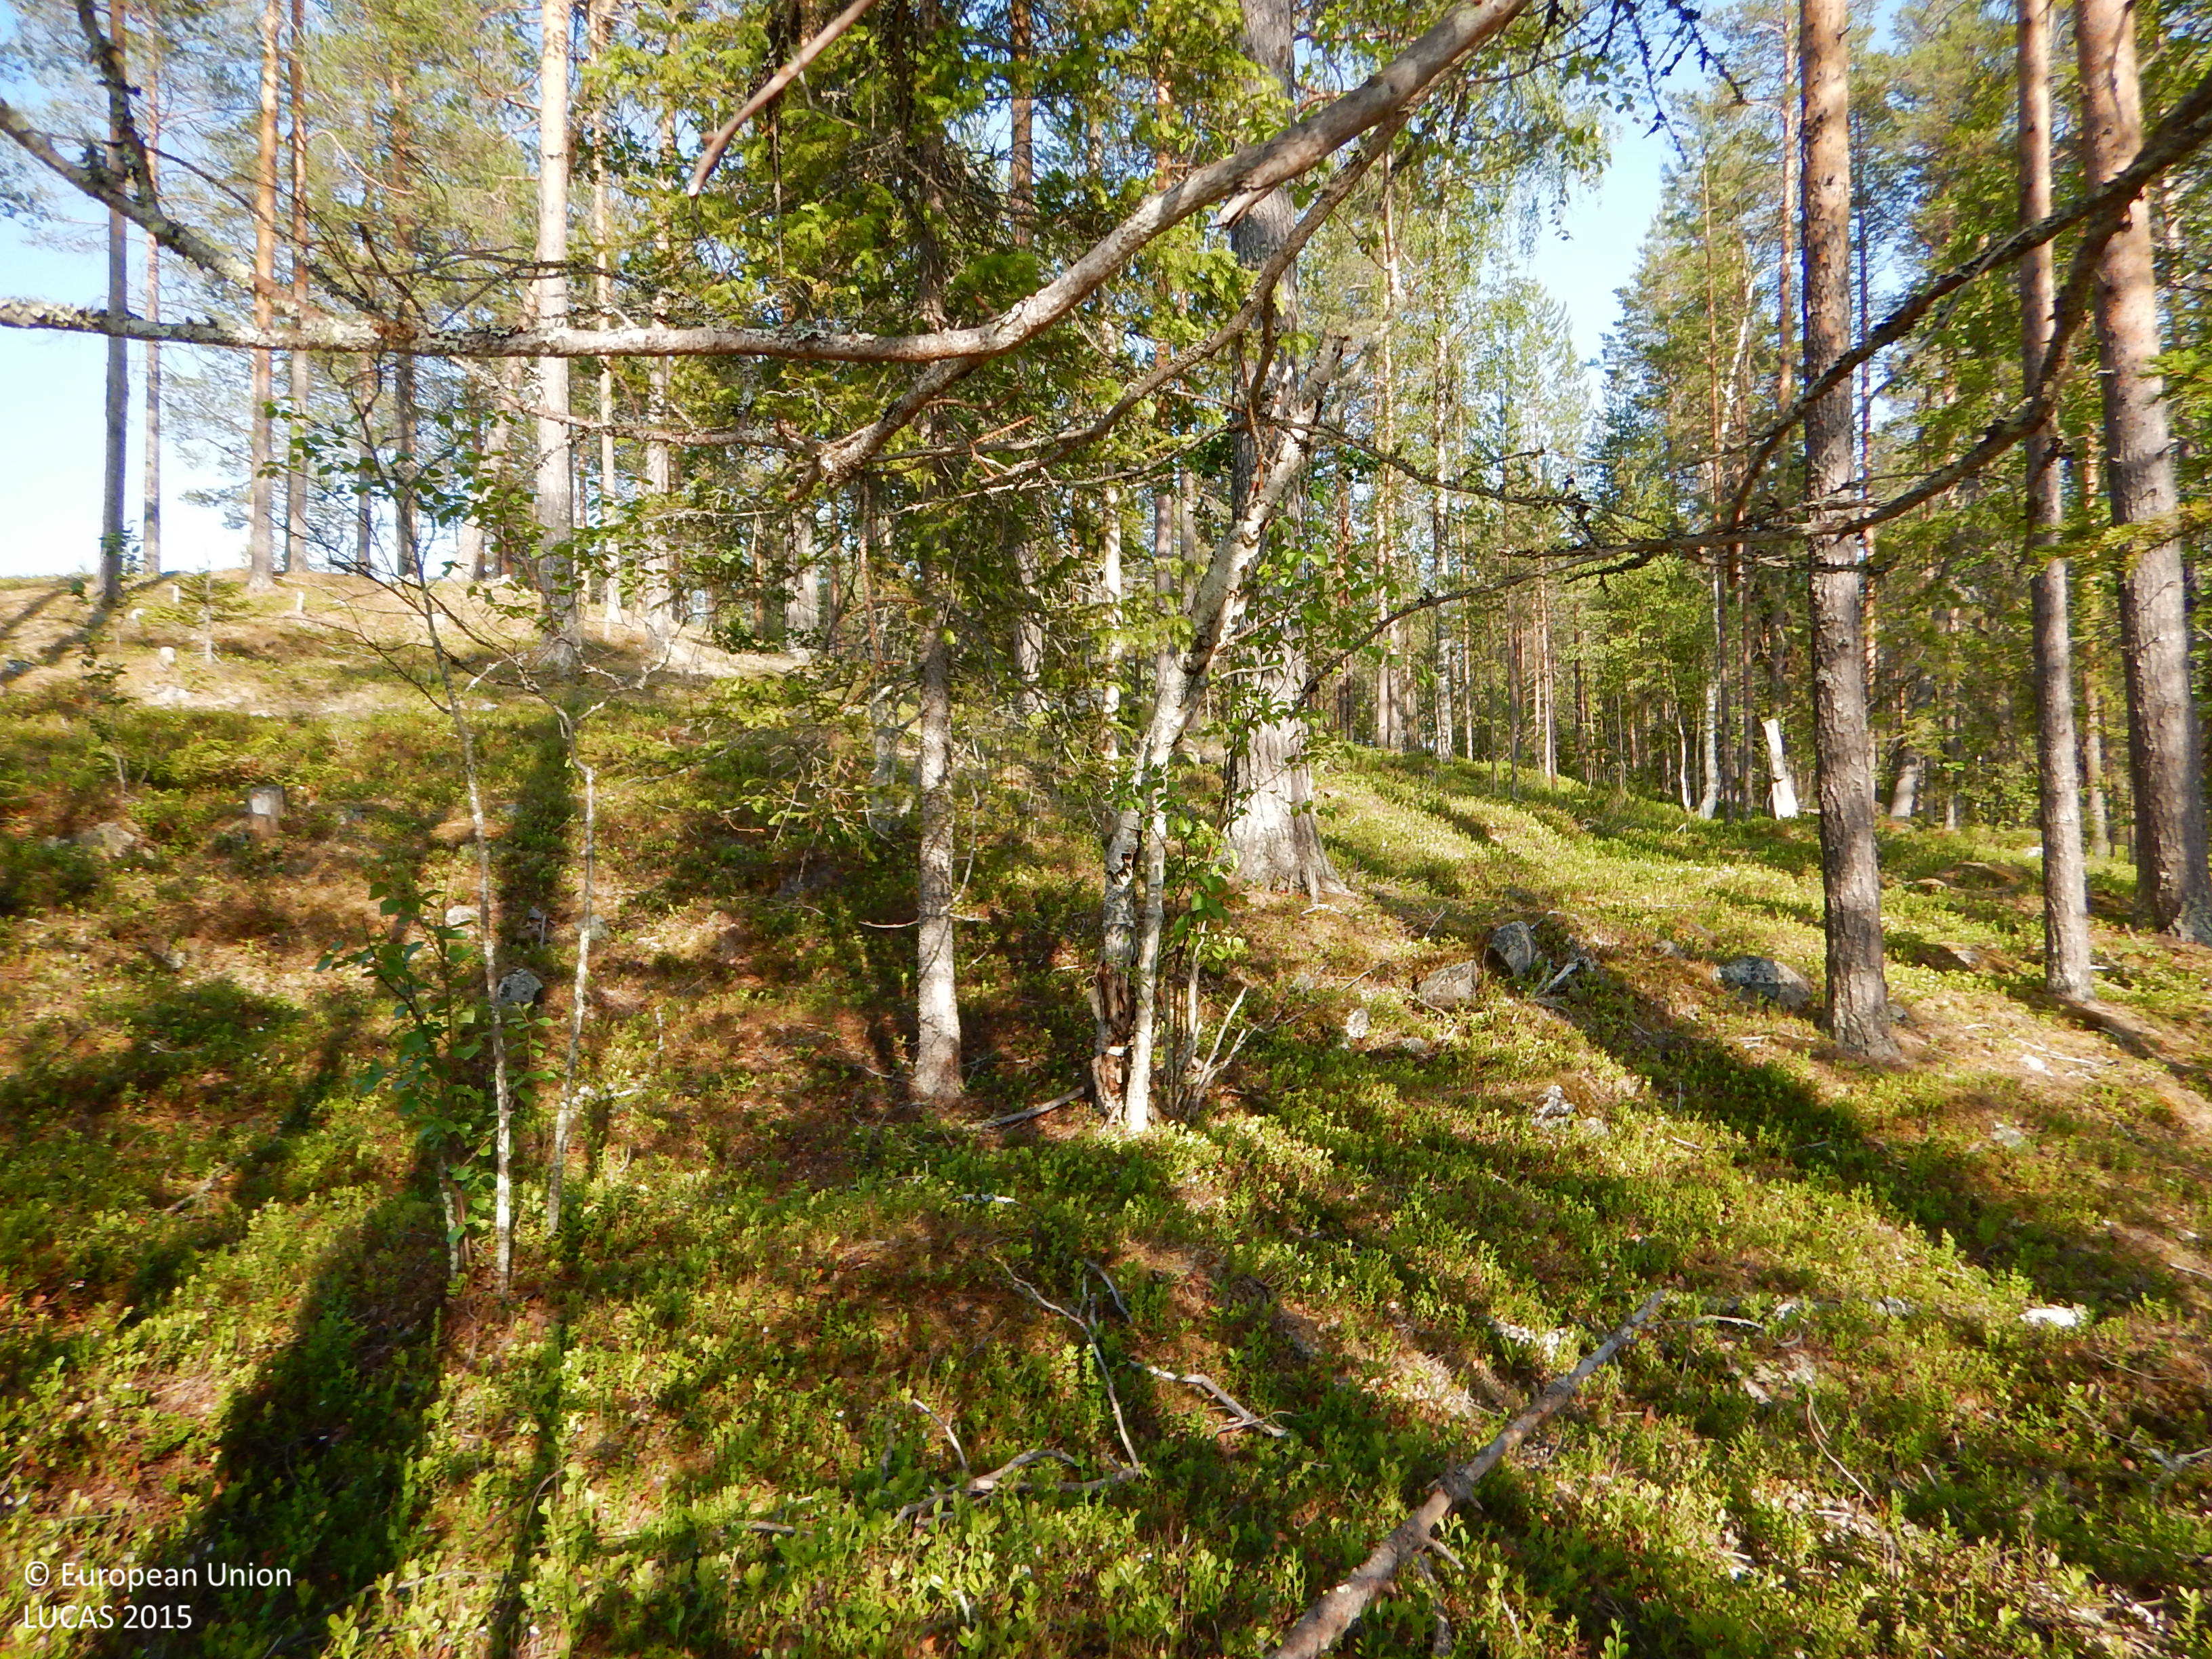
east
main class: Woodland
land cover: Pine dominated coniferous woodland
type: boreal forest
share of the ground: 50 - 75 %
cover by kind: coniferous forest trees 50 %, lichens and mosses 15 %, shrubs 10 %, herbaceous plants 10 %, broadleaved forest trees 5 %, consolidated bare surface 5 %, unconsolidated bare surface 5 %
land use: Forestry
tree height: > 5 m
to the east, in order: Pine dominated coniferous woodland
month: September
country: SE
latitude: 64.9656
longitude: 20.1578
